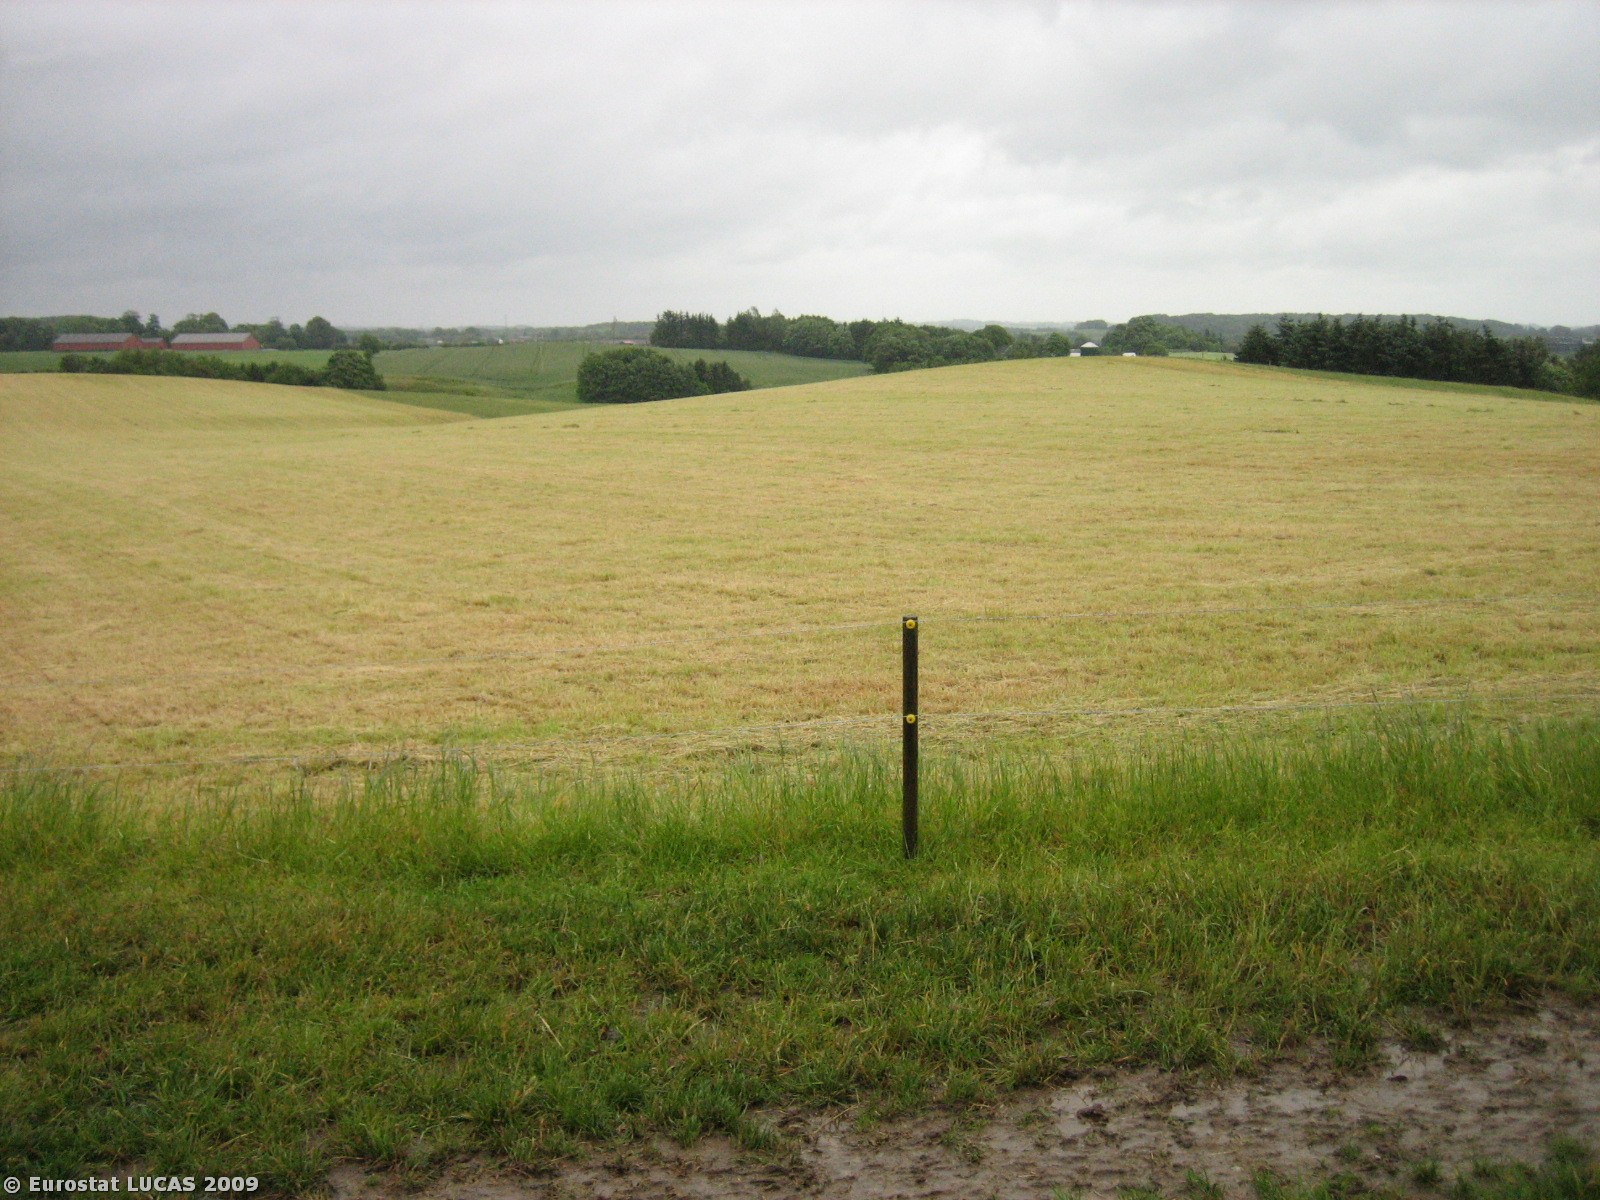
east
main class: Grassland
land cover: Grassland without tree/shrub cover
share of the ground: 50 - 75 %
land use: Agriculture (excluding fallow land and kitchen gardens)
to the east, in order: Grassland without tree/shrub cover; Fences; Grassland without tree/shrub cover
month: June
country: DK
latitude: 56.0799
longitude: 9.9840
